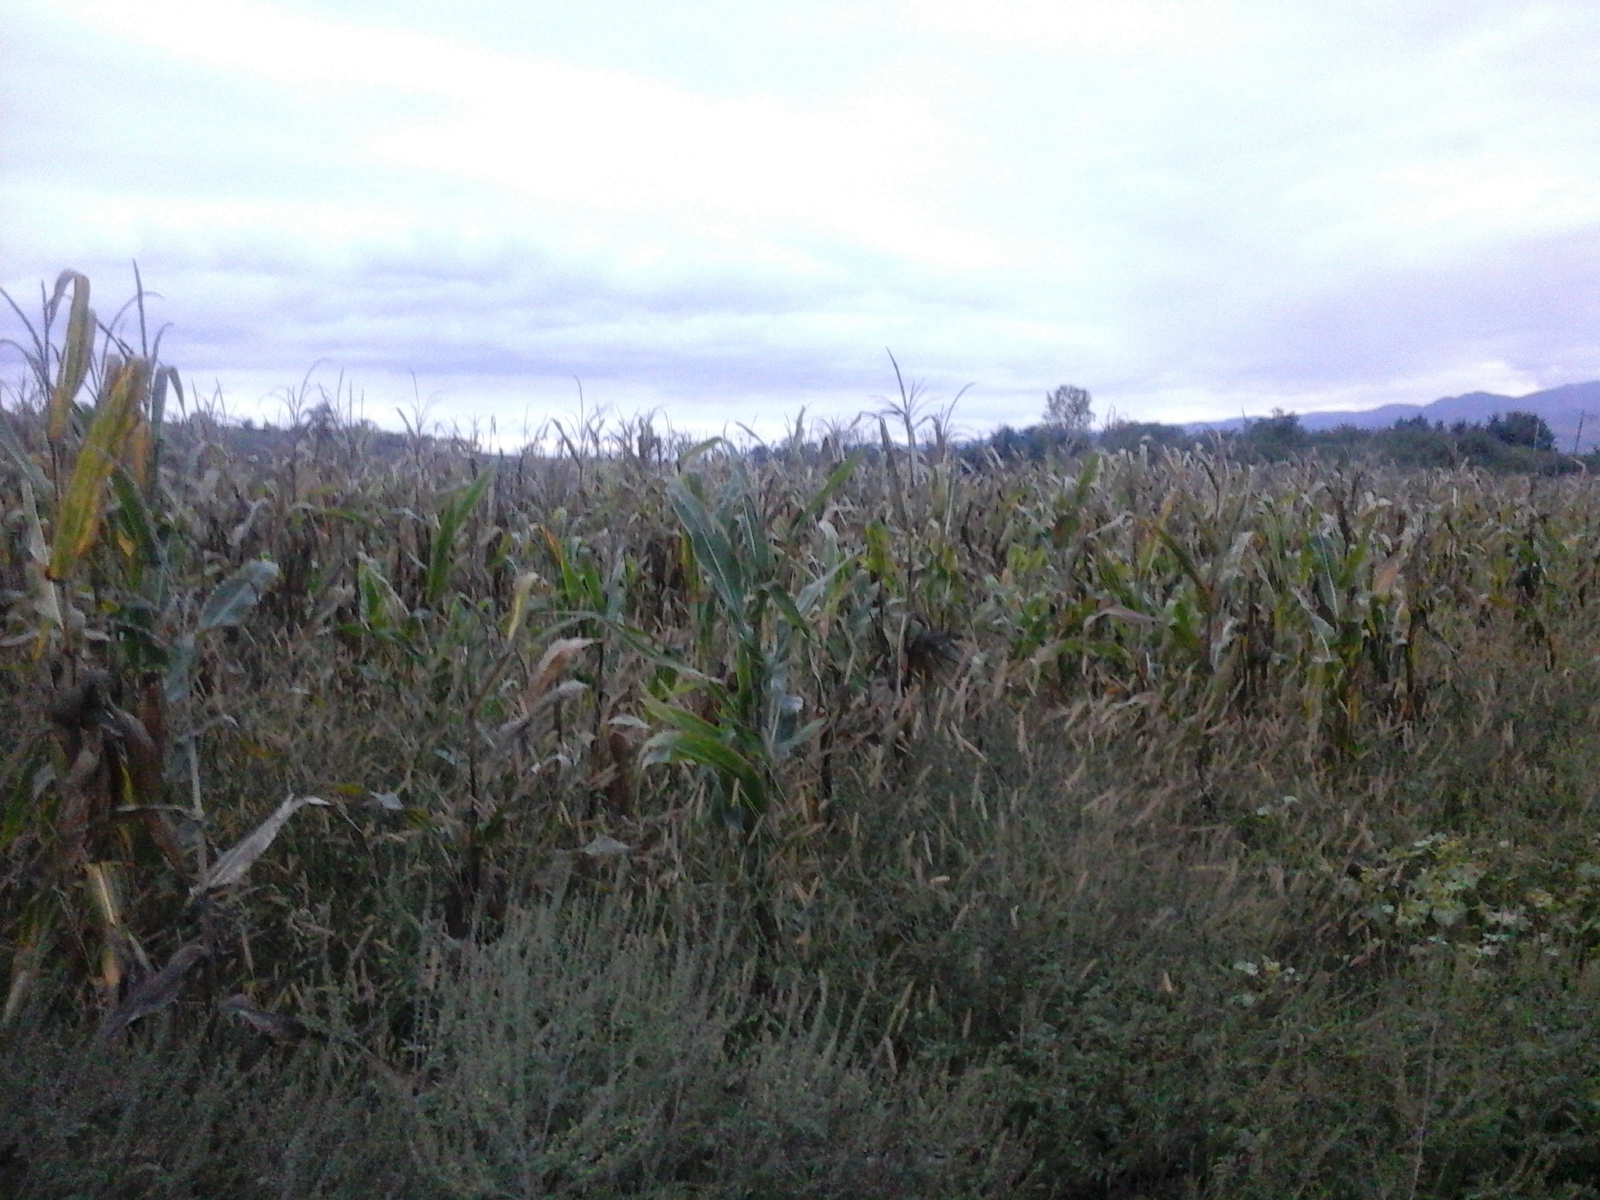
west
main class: Grassland
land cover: Spontaneously vegetated surfaces
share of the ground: > 75 %
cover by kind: herbaceous plants 100 %
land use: Fallow land
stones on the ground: < 10 %
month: September
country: RO
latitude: 46.0264
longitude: 23.5920
